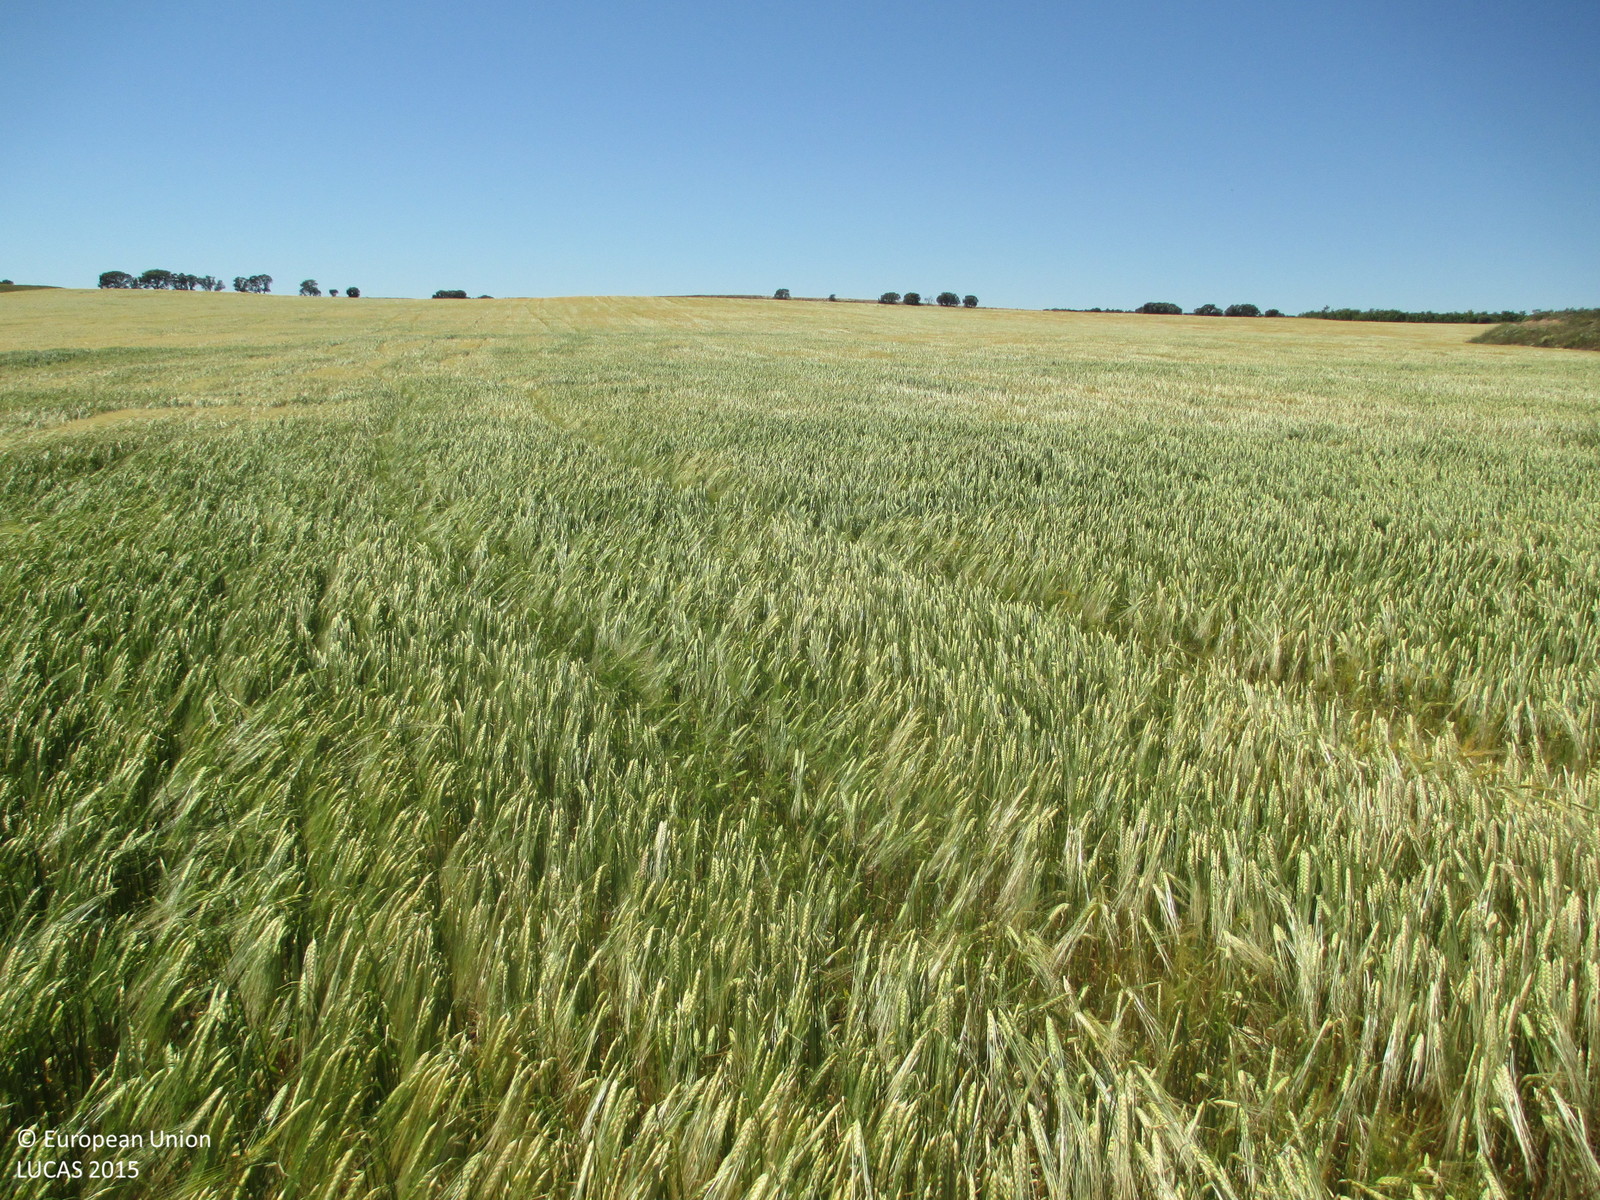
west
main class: Cropland
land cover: Barley
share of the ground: > 75 %
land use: Agriculture (excluding fallow land and kitchen gardens)
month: May
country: ES
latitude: 42.0284
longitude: -0.2021
